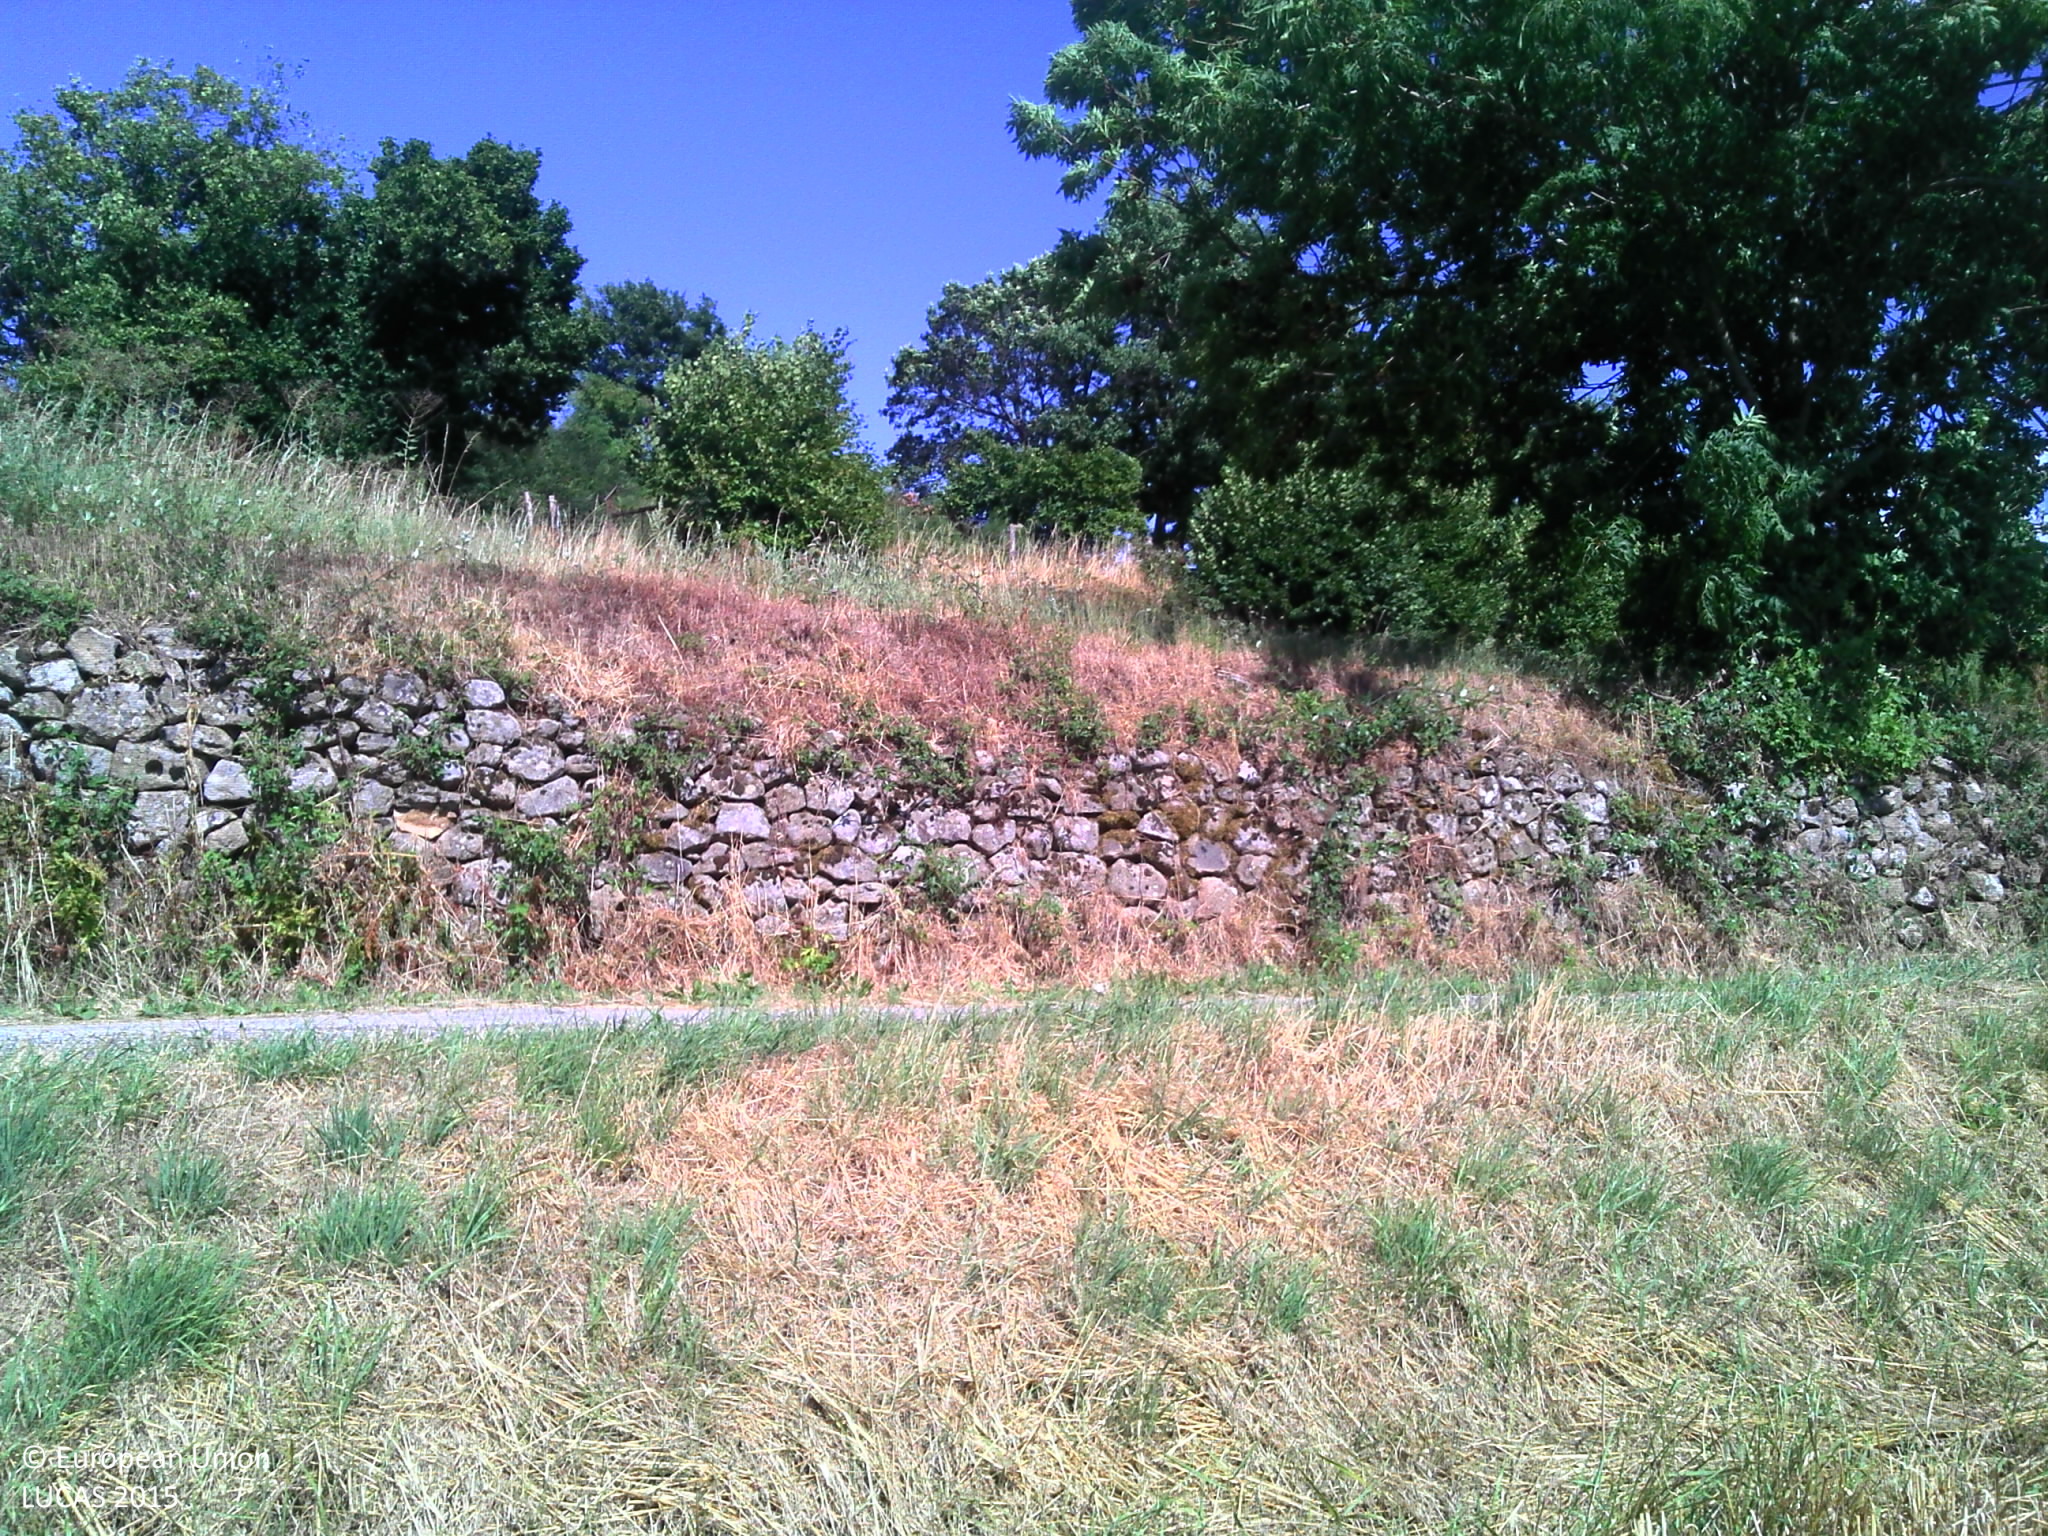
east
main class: Cropland
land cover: Barley
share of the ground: > 75 %
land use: Agriculture (excluding fallow land and kitchen gardens)
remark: Harvested field
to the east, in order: Barley; Dry stone walls; Paved roads, cycling and walking lanes; Dry stone walls; Grassland with sparse tree/shrub cover; Tracks; Grassland with sparse tree/shrub cover; Lines of trees; Grassland without tree/shrub cover; Fences; Grassland without tree/shrub cover; Fences; Tracks; Grassland without tree/shrub cover; Tracks; Spruce dominated coniferous woodland; Shrubland without tree cover
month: July
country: FR
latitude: 44.9145
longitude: 4.5967
